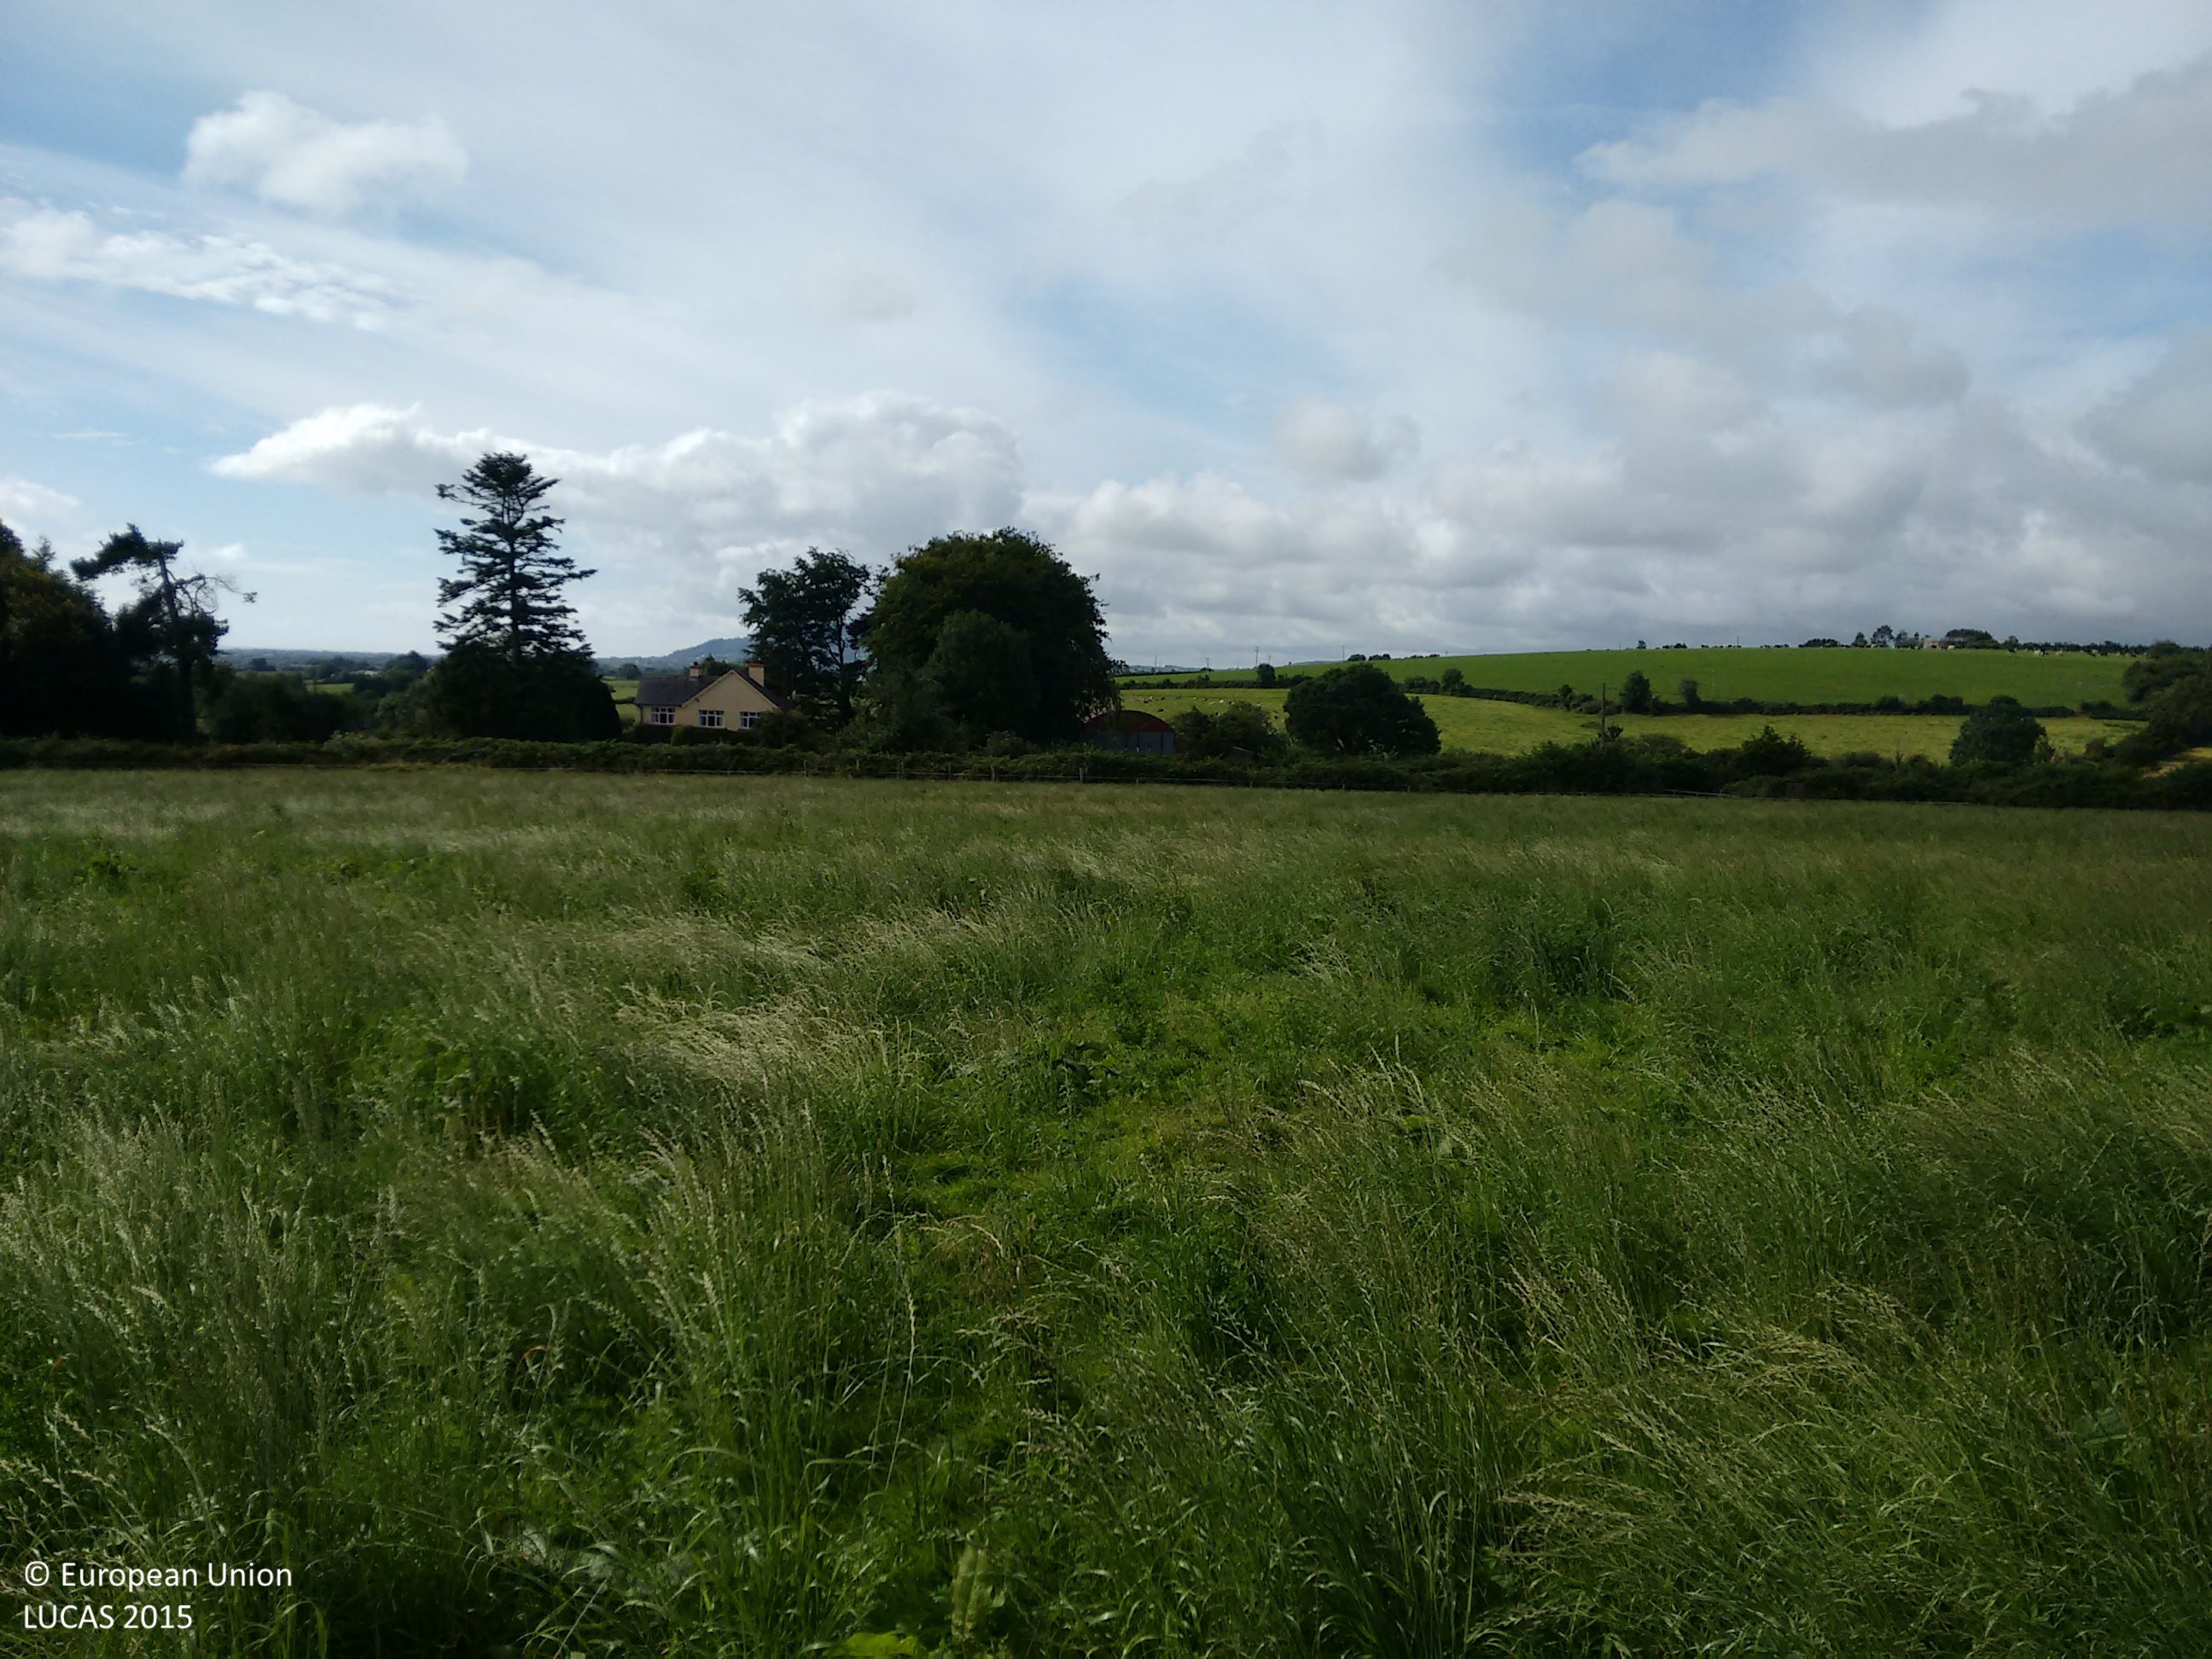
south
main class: Grassland
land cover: Grassland without tree/shrub cover
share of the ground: > 75 %
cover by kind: herbaceous plants 100 %
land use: Agriculture (excluding fallow land and kitchen gardens)
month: August
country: IE
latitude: 52.7734
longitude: -6.2324
